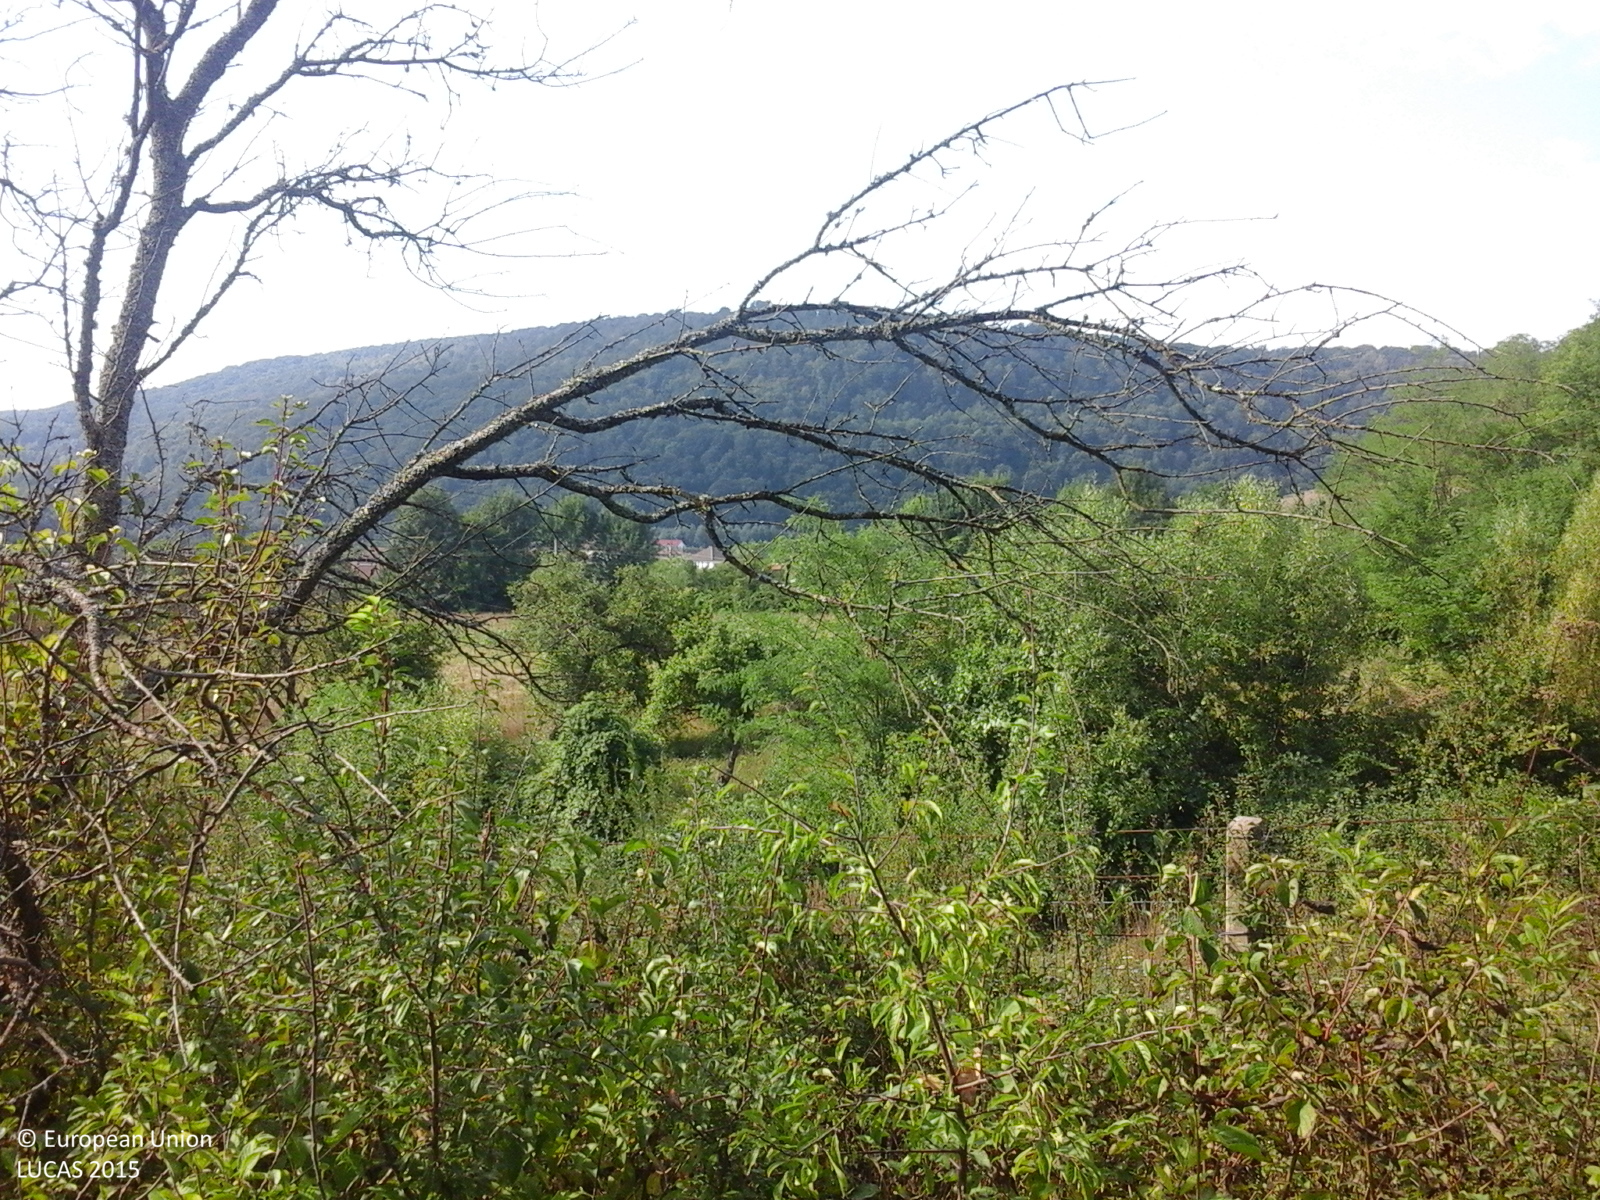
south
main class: Cropland
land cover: Apple fruit
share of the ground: 25 - 50 %
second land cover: Grassland without tree/shrub cover
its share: > 75 %
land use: Agriculture (excluding fallow land and kitchen gardens)
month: August
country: RO
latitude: 46.3837
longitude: 22.1512
